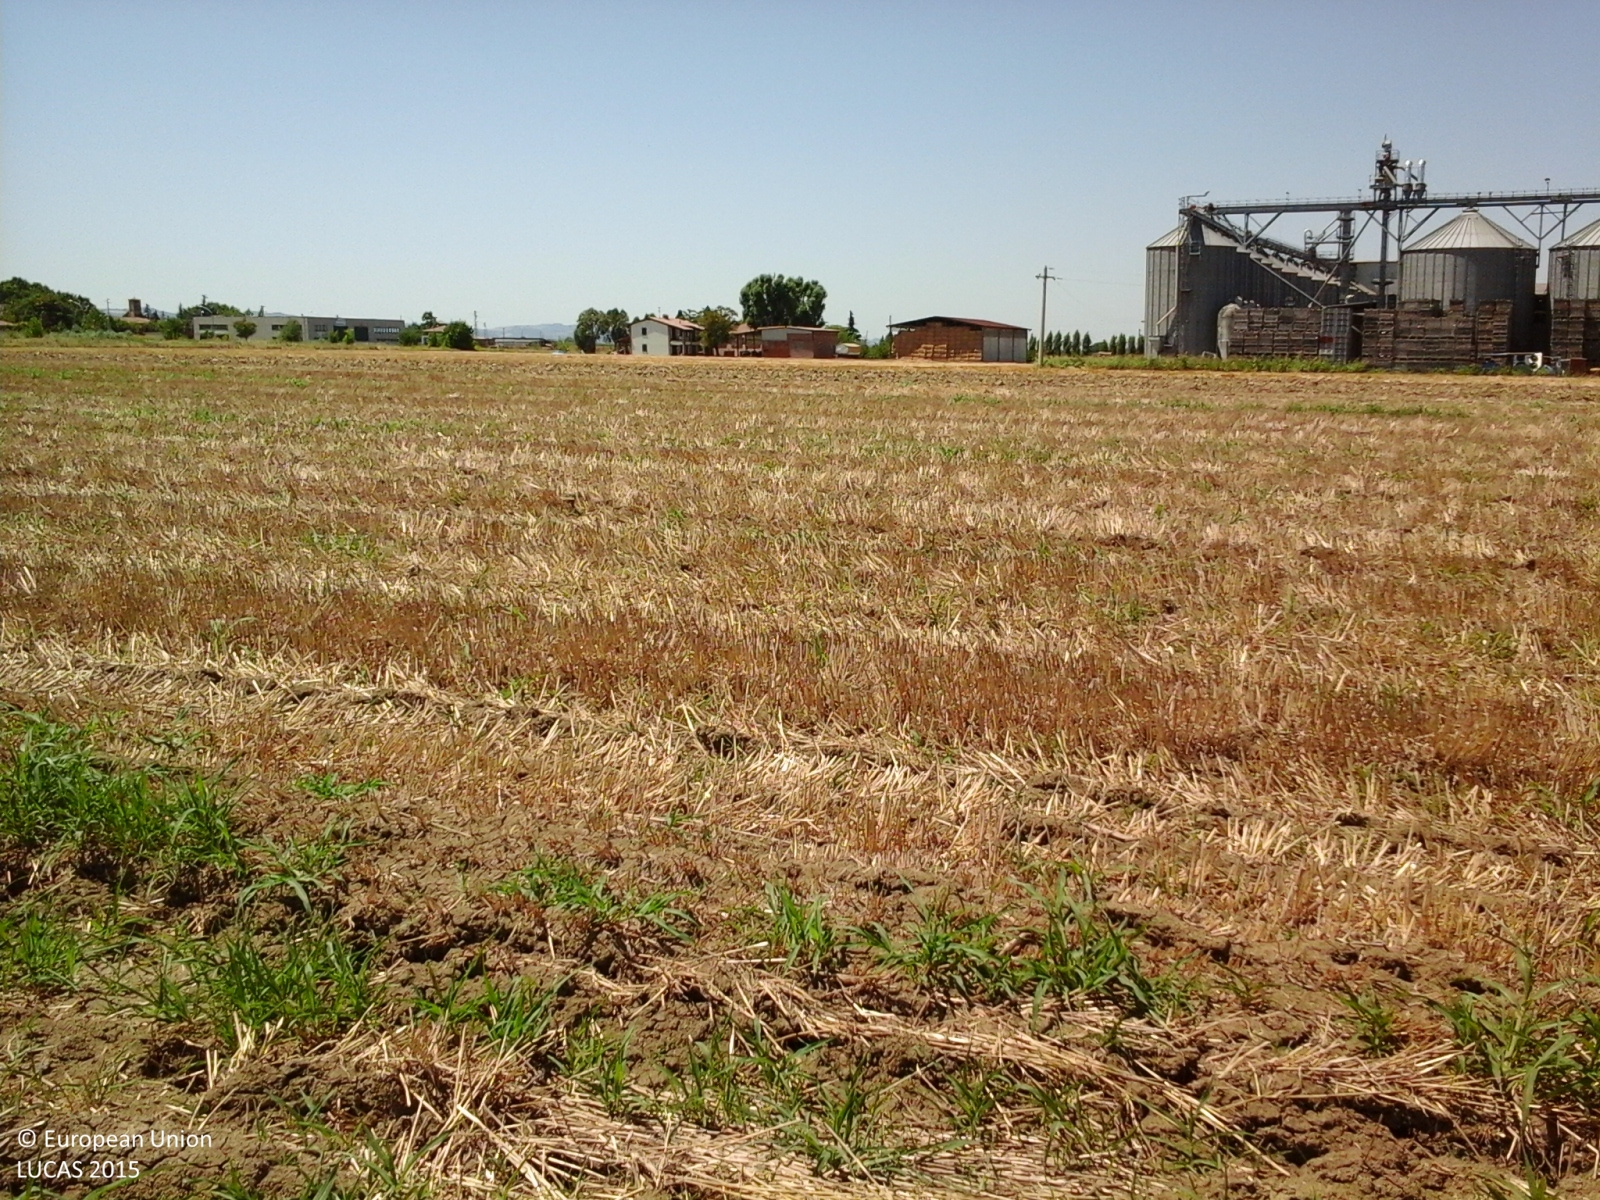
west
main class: Cropland
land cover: Common wheat
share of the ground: > 75 %
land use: Agriculture (excluding fallow land and kitchen gardens)
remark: Harvested field
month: July
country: IT
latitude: 44.4462
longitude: 11.6174
